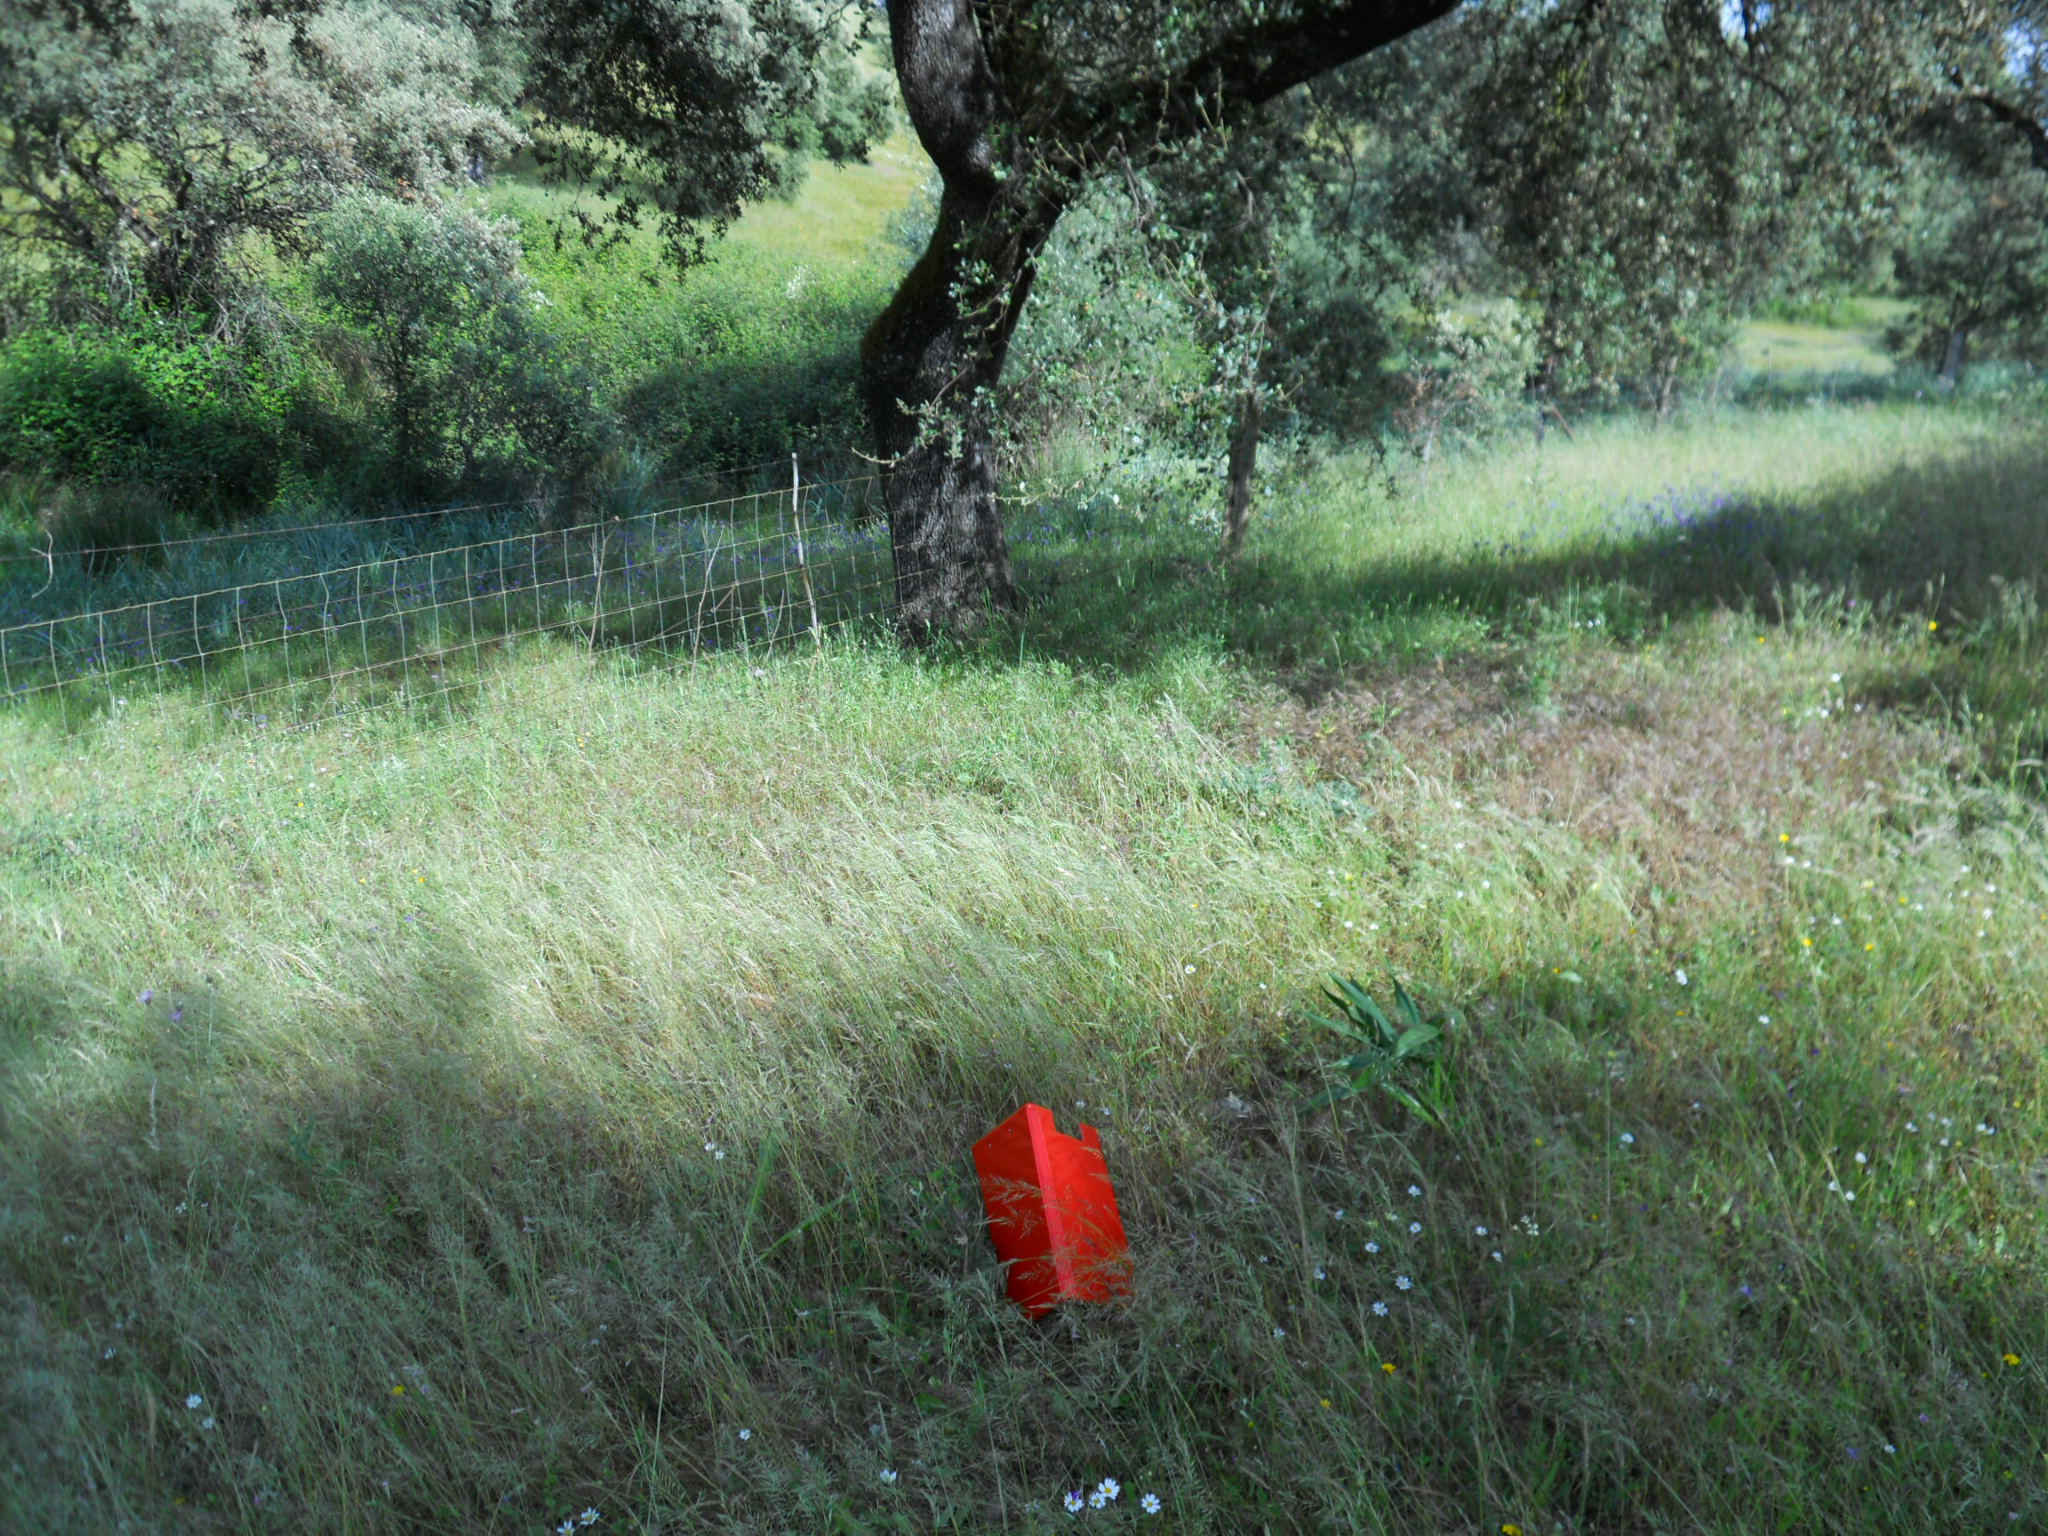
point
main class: Woodland
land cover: Broadleaved woodland
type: broadleaved evergreen forest
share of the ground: > 75 %
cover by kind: broadleaved forest trees 90 %, herbaceous plants 10 %
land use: Forestry
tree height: > 5 m
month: May
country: ES
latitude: 39.0816
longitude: -6.9152
